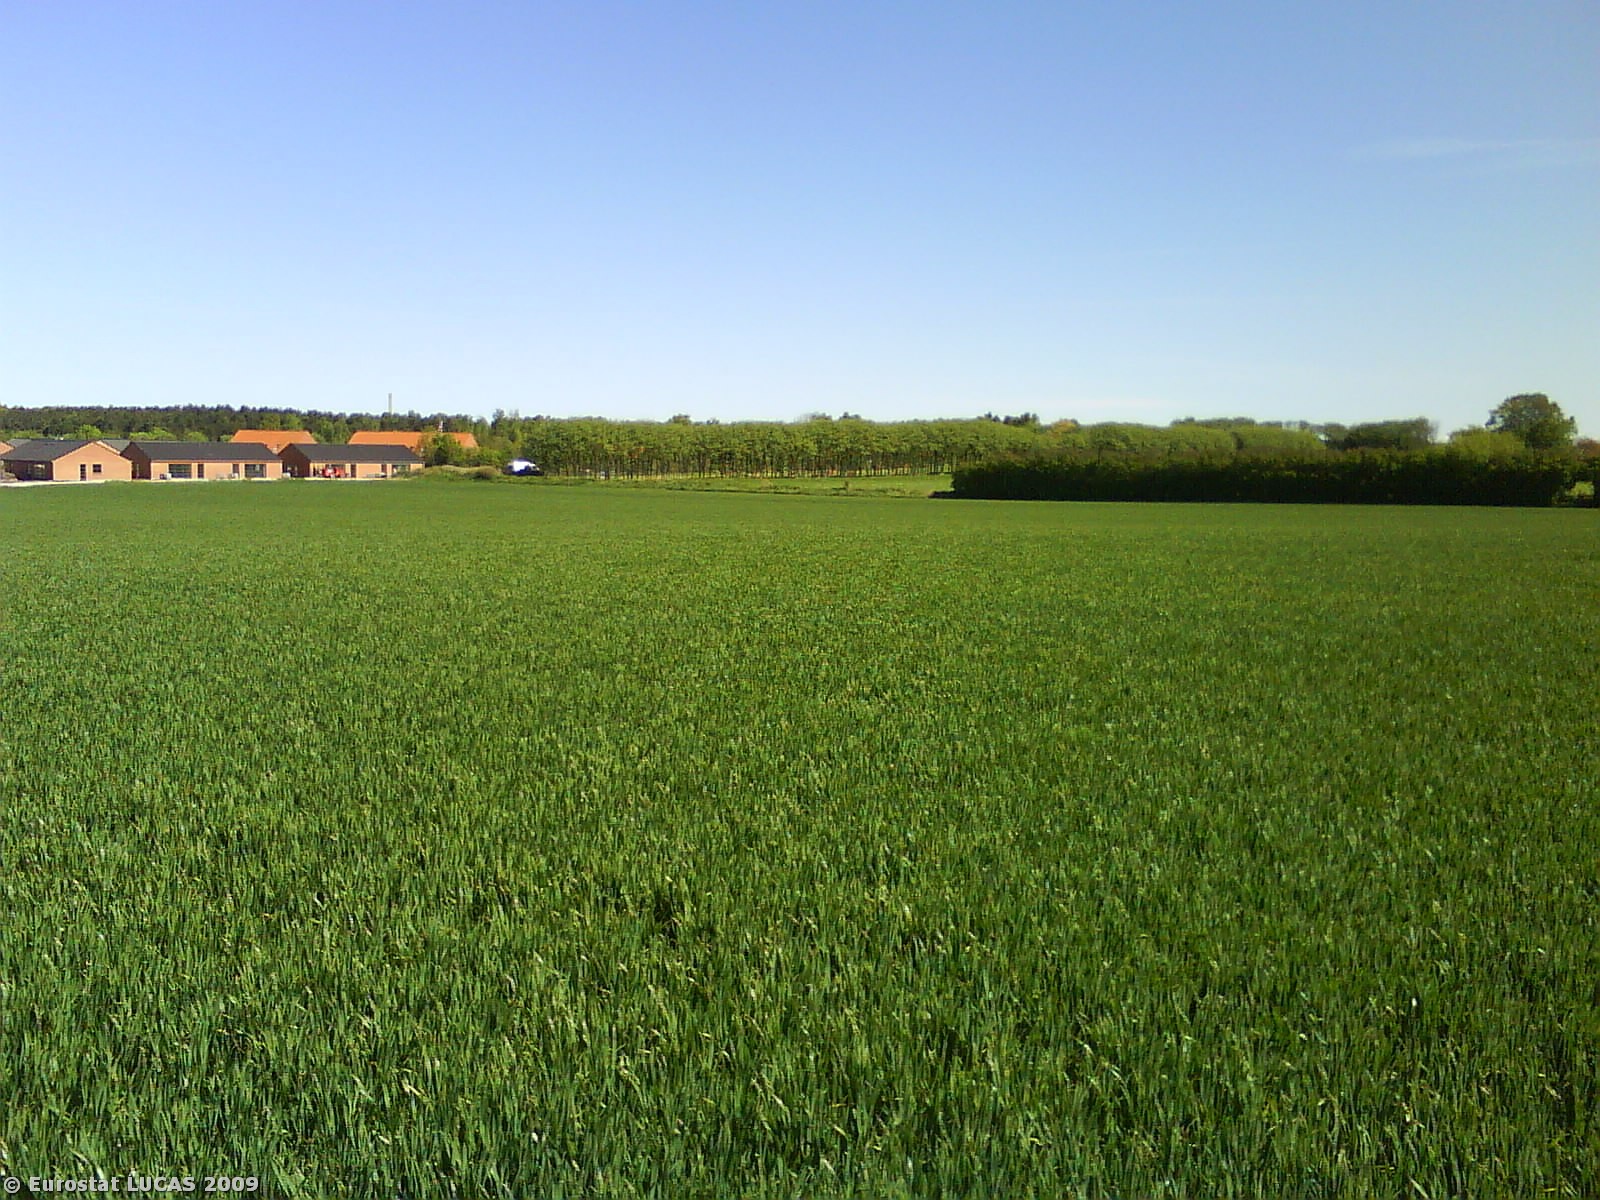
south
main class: Cropland
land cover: Common wheat
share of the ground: > 75 %
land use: Agriculture (excluding fallow land and kitchen gardens)
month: May
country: DK
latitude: 56.3824
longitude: 10.8896
